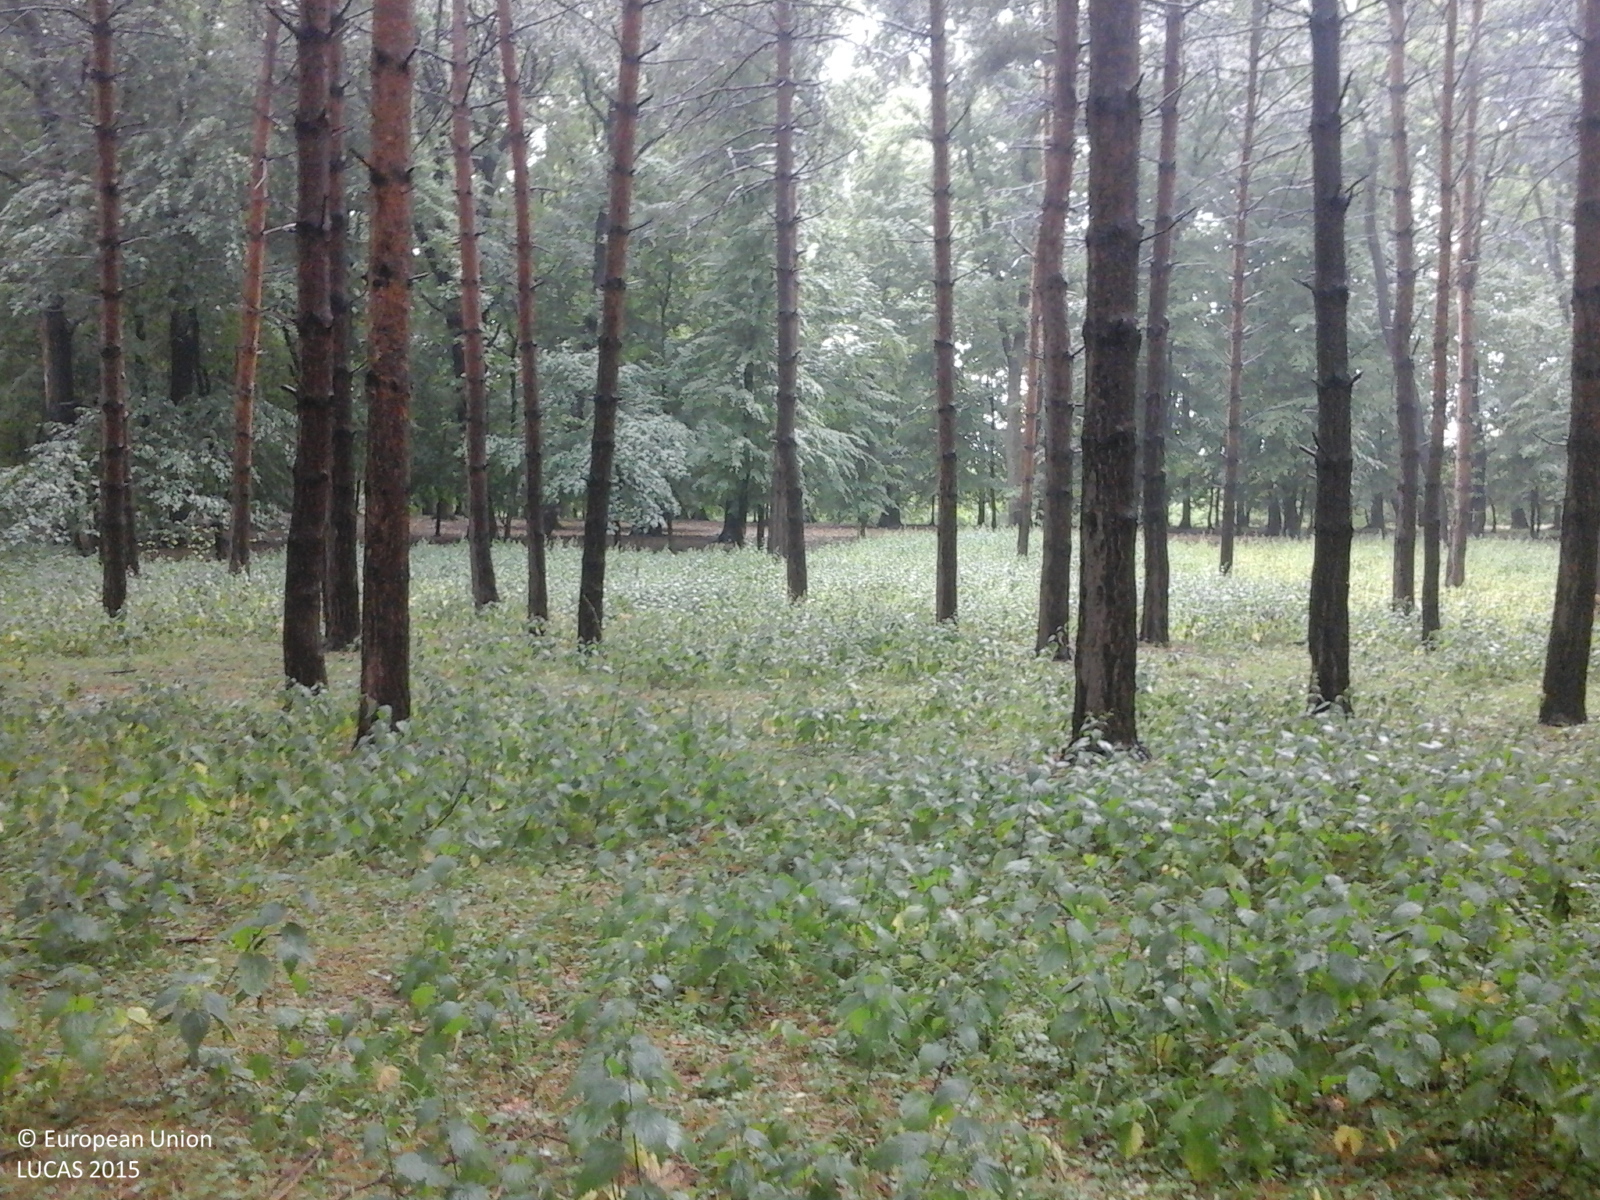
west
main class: Woodland
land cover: Pine dominated coniferous woodland
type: hemiboreal forest and nemoral coniferous forest and mixed broadleaved-coniferous forest
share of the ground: > 75 %
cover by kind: coniferous forest trees 95 %, broadleaved forest trees 5 %
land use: Forestry
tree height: > 5 m
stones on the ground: 10 - 25 %
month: June
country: RO
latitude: 47.3908
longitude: 26.8567
